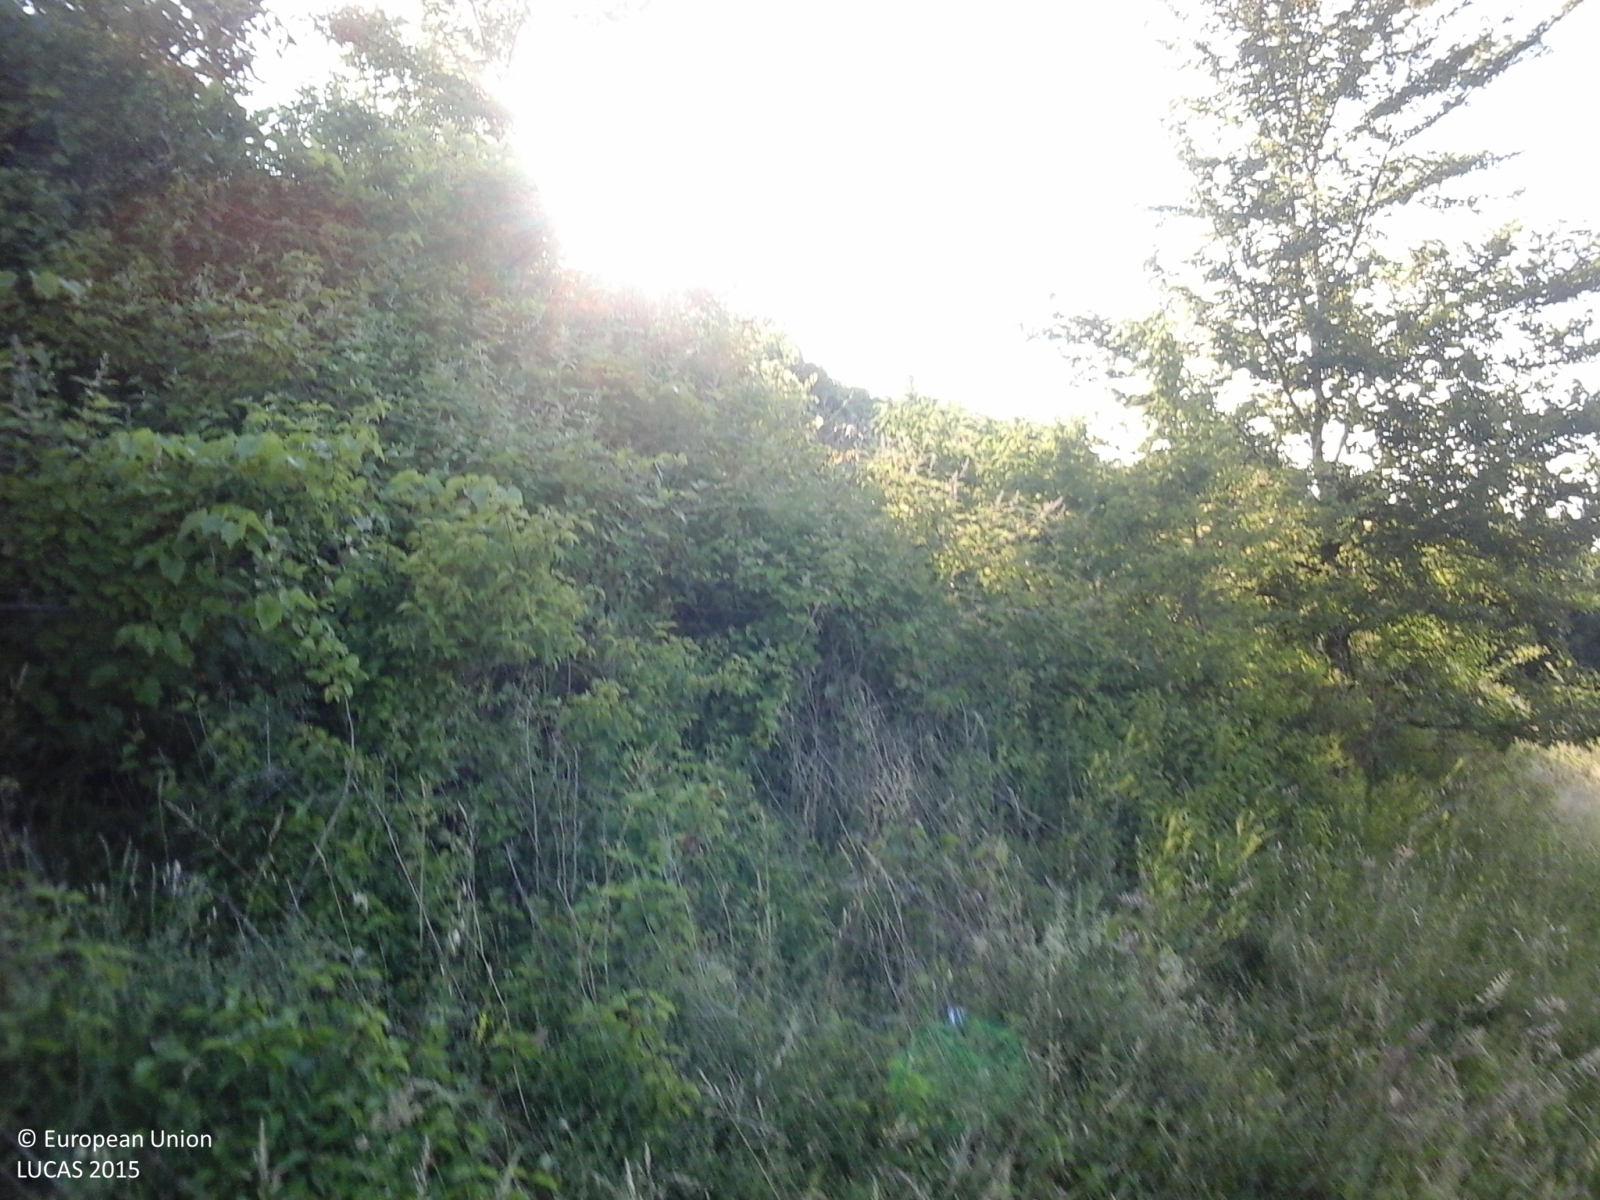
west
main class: Shrubland
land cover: Shrubland without tree cover
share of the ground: > 75 %
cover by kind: shrubs 100 %
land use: Semi-natural and natural areas not in use
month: June
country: IT
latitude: 42.8910
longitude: 13.7733
